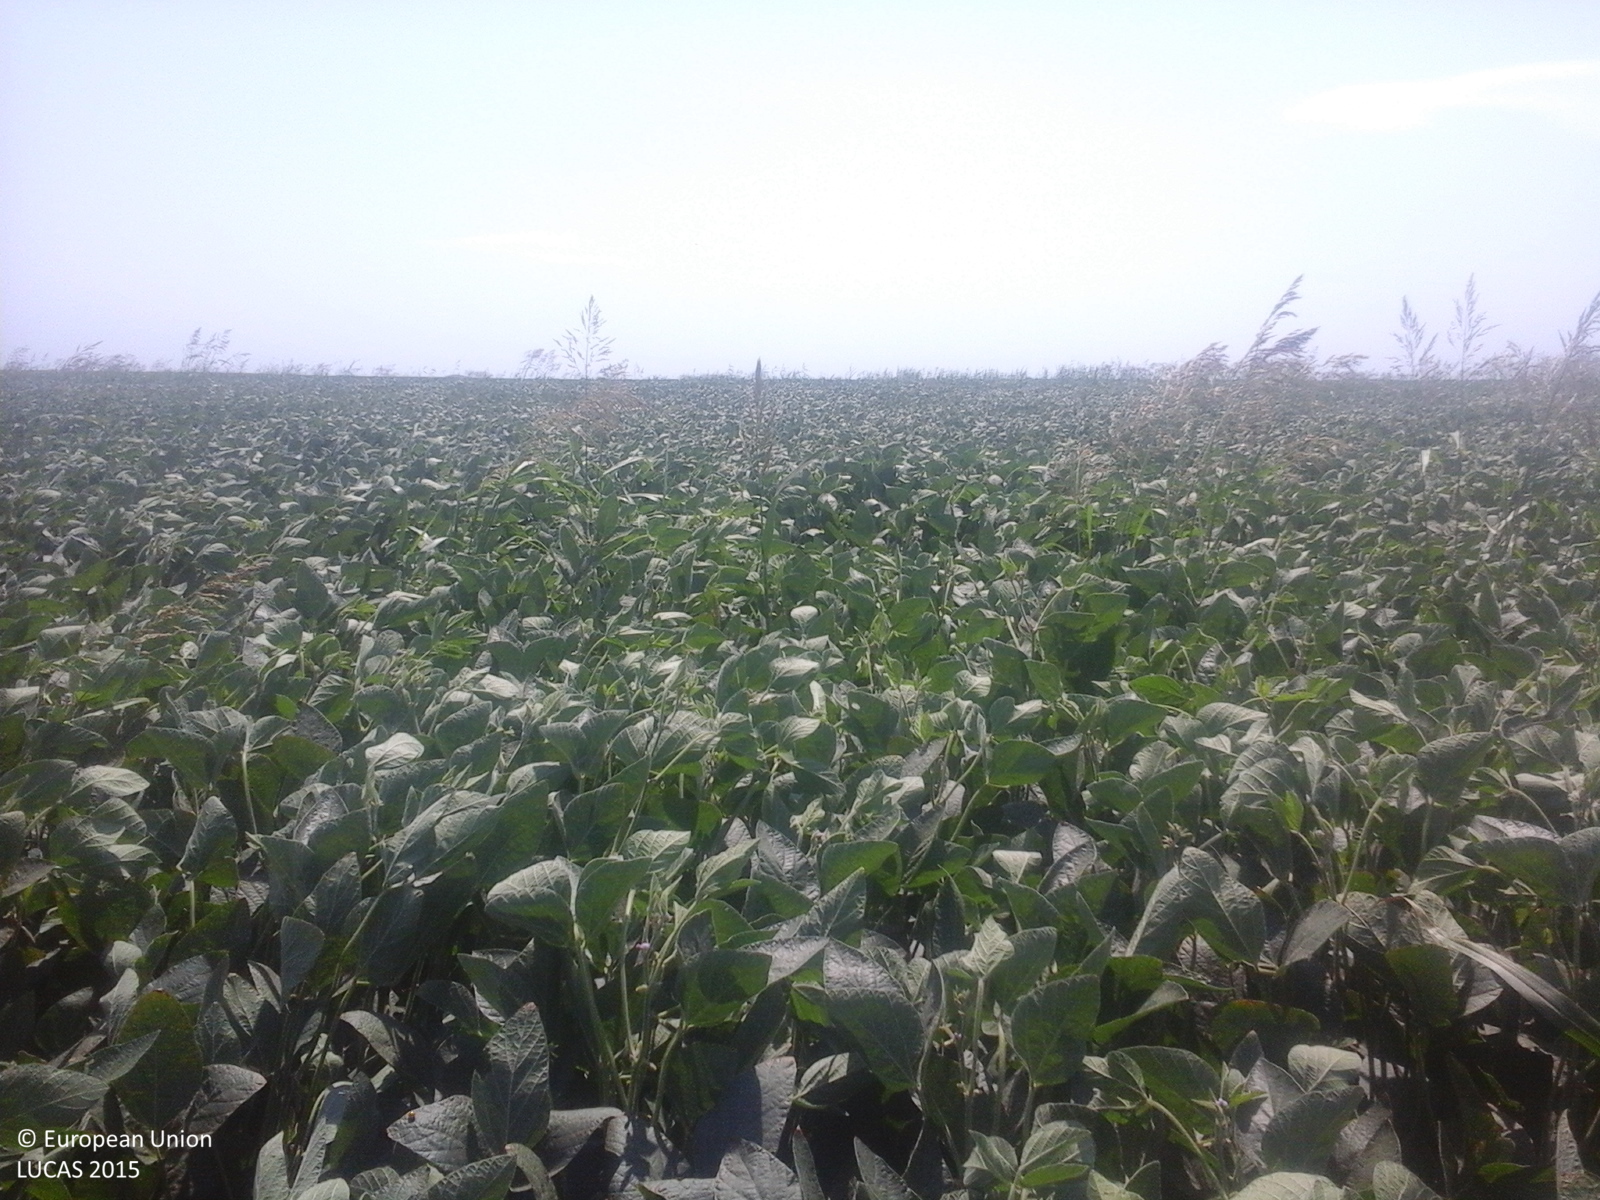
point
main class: Cropland
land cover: Soya
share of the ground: > 75 %
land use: Agriculture (excluding fallow land and kitchen gardens)
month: August
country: RO
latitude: 45.1551
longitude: 27.6971
